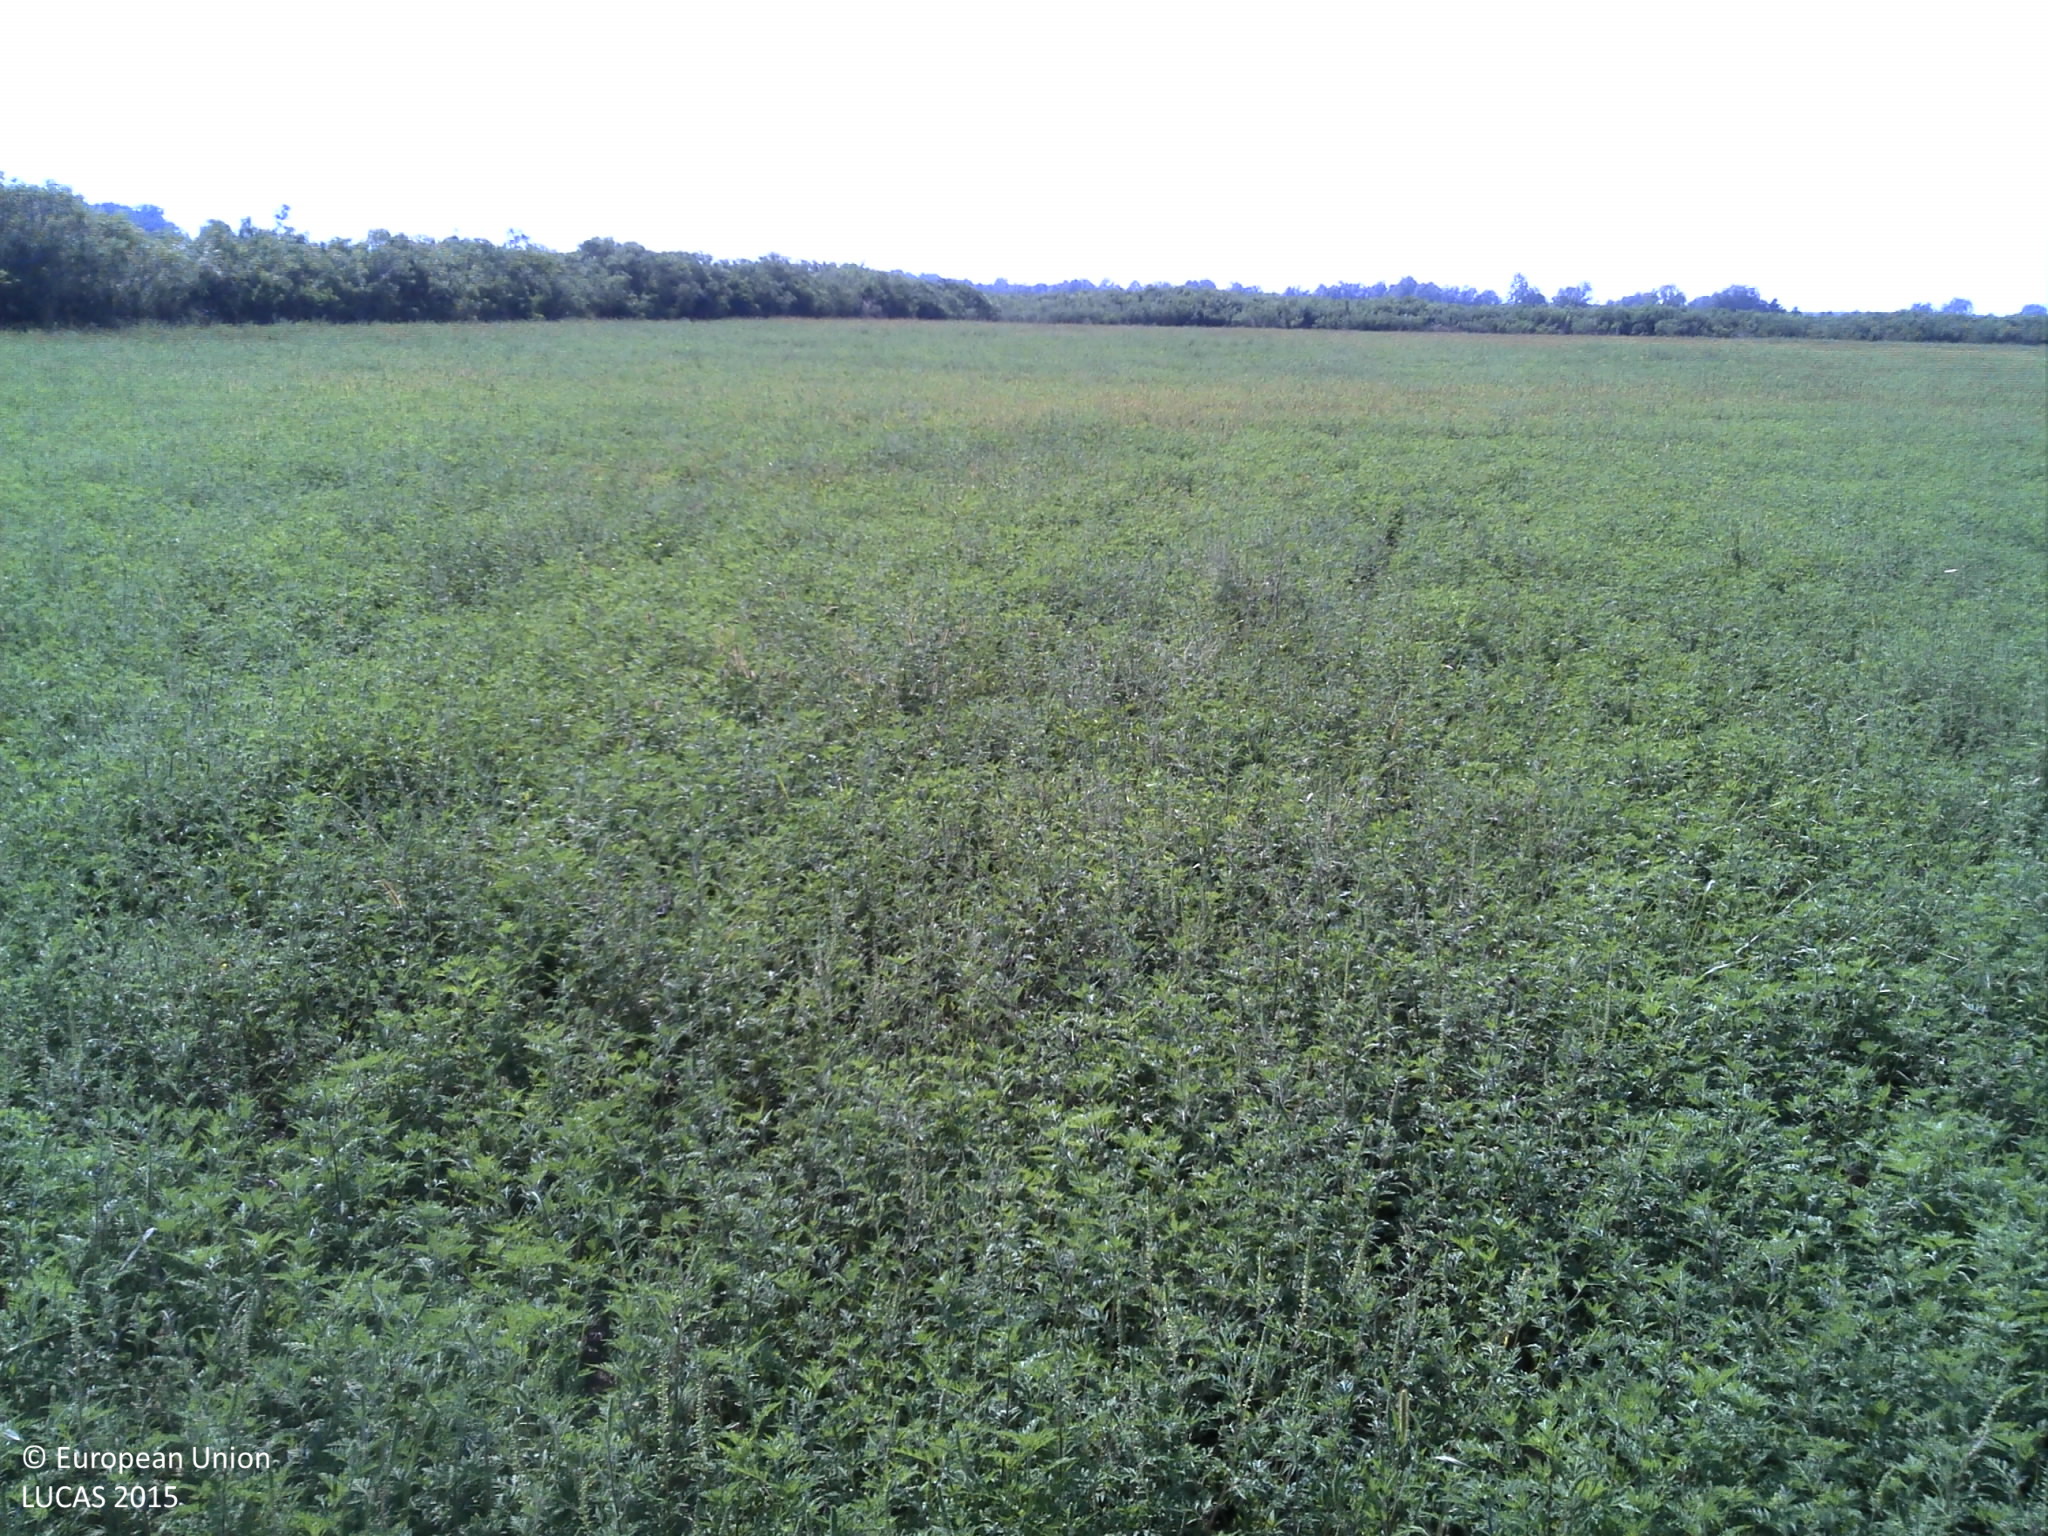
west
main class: Grassland
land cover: Spontaneously vegetated surfaces
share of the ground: > 75 %
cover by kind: herbaceous plants 100 %
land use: Fallow land
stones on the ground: < 10 %
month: August
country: HR
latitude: 45.2064
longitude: 17.1671
